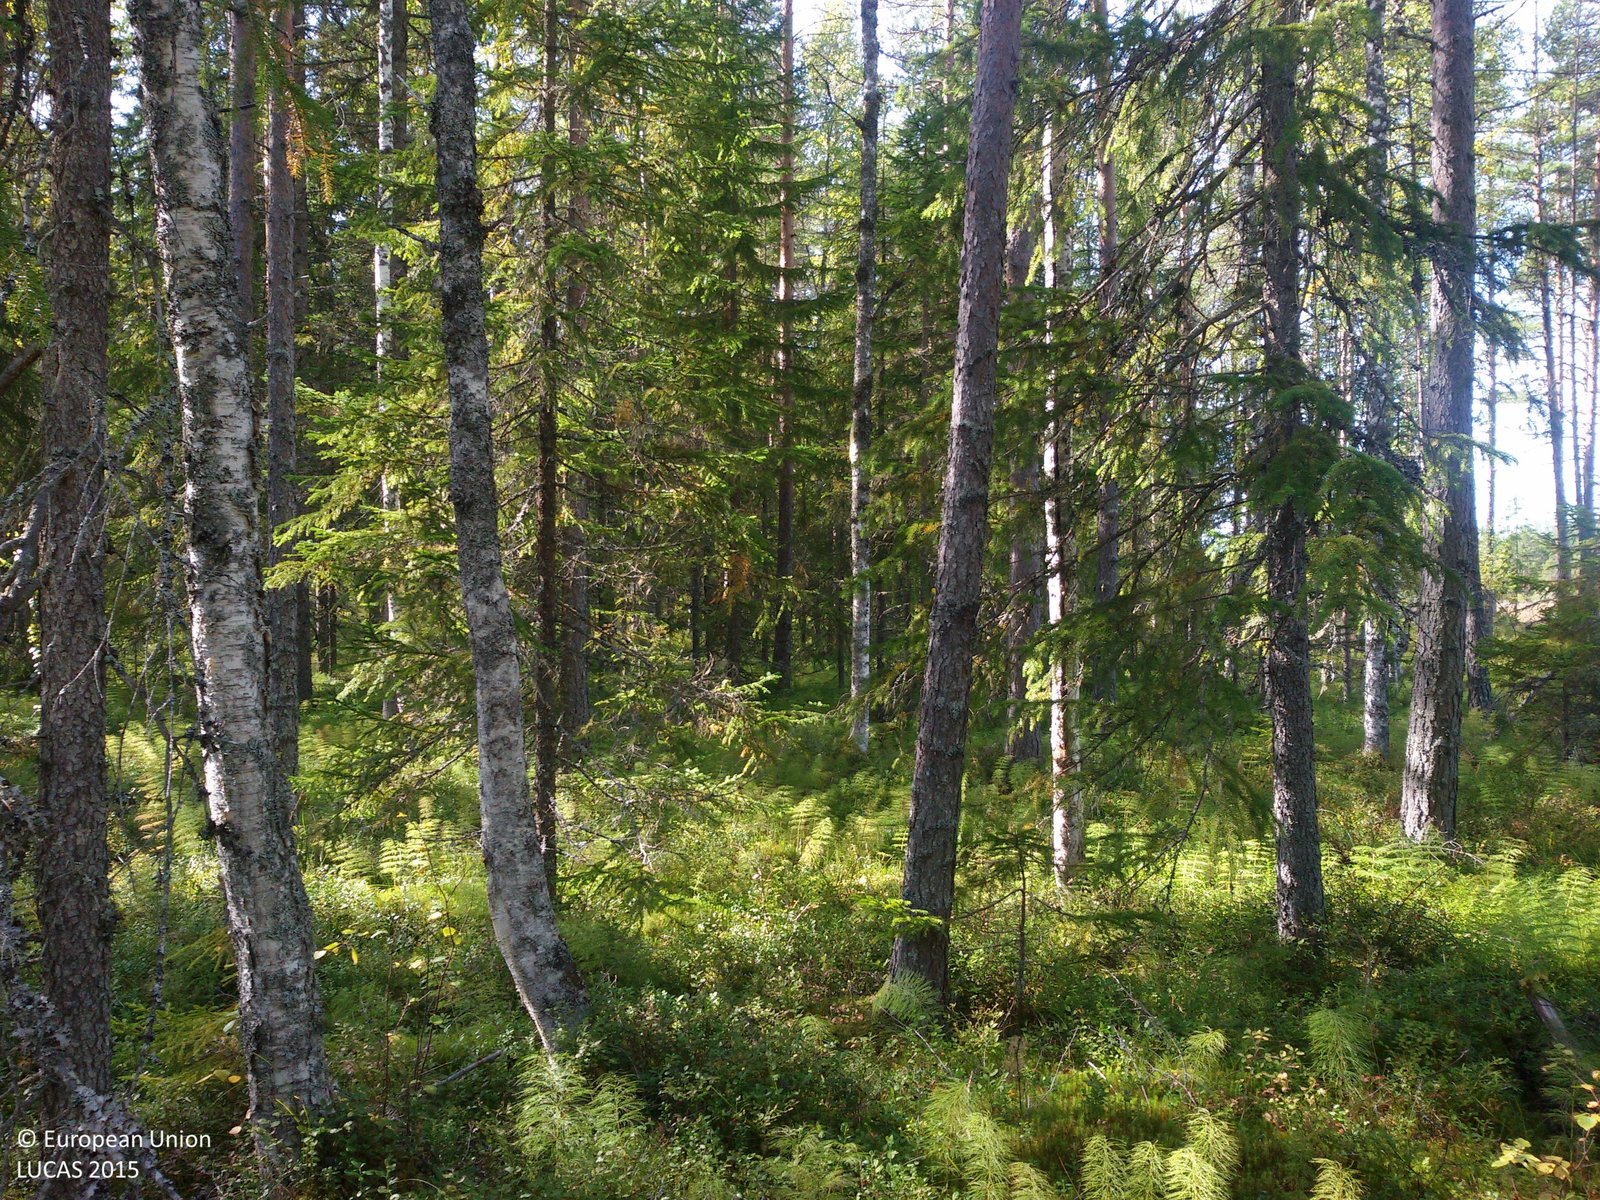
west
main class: Woodland
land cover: Pine dominated mixed woodland
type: boreal forest
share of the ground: 50 - 75 %
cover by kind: coniferous forest trees 40 %, broadleaved forest trees 30 %, lichens and mosses 20 %, herbaceous plants 10 %
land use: Forestry
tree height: > 5 m
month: September
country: SE
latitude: 61.0020
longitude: 15.2931
